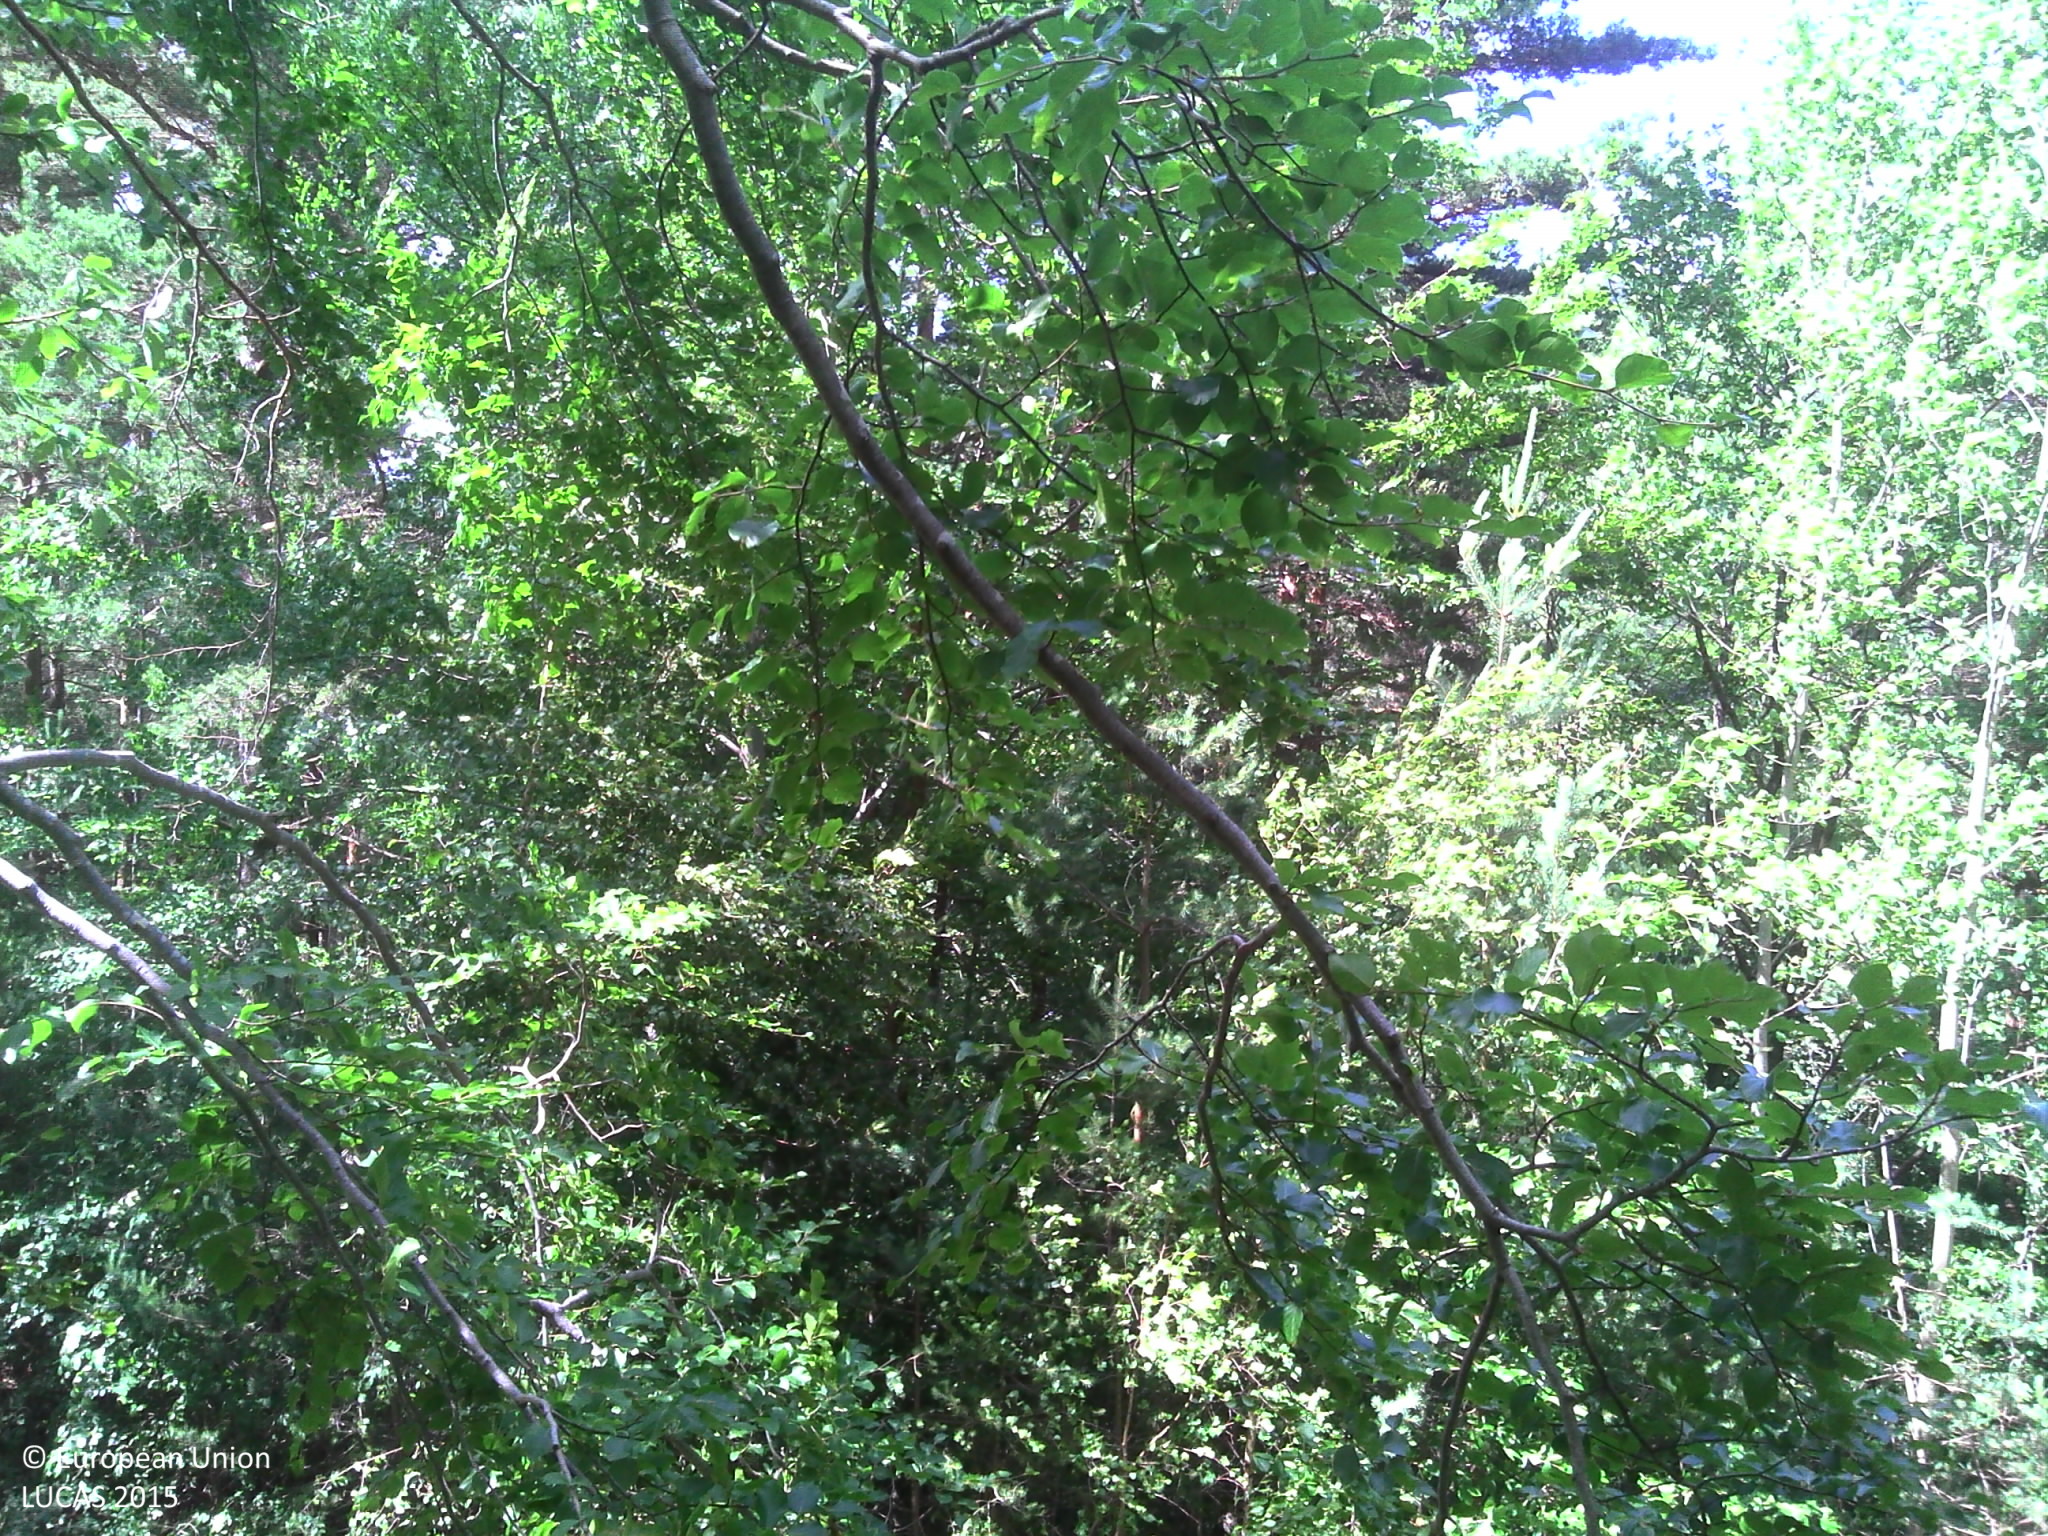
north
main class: Woodland
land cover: Other mixed woodland
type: mountainous beech forest
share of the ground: > 75 %
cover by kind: broadleaved forest trees 65 %, coniferous forest trees 25 %, herbaceous plants 10 %
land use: Forestry
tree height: > 5 m
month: June
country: FR
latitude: 44.5703
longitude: 3.9238
